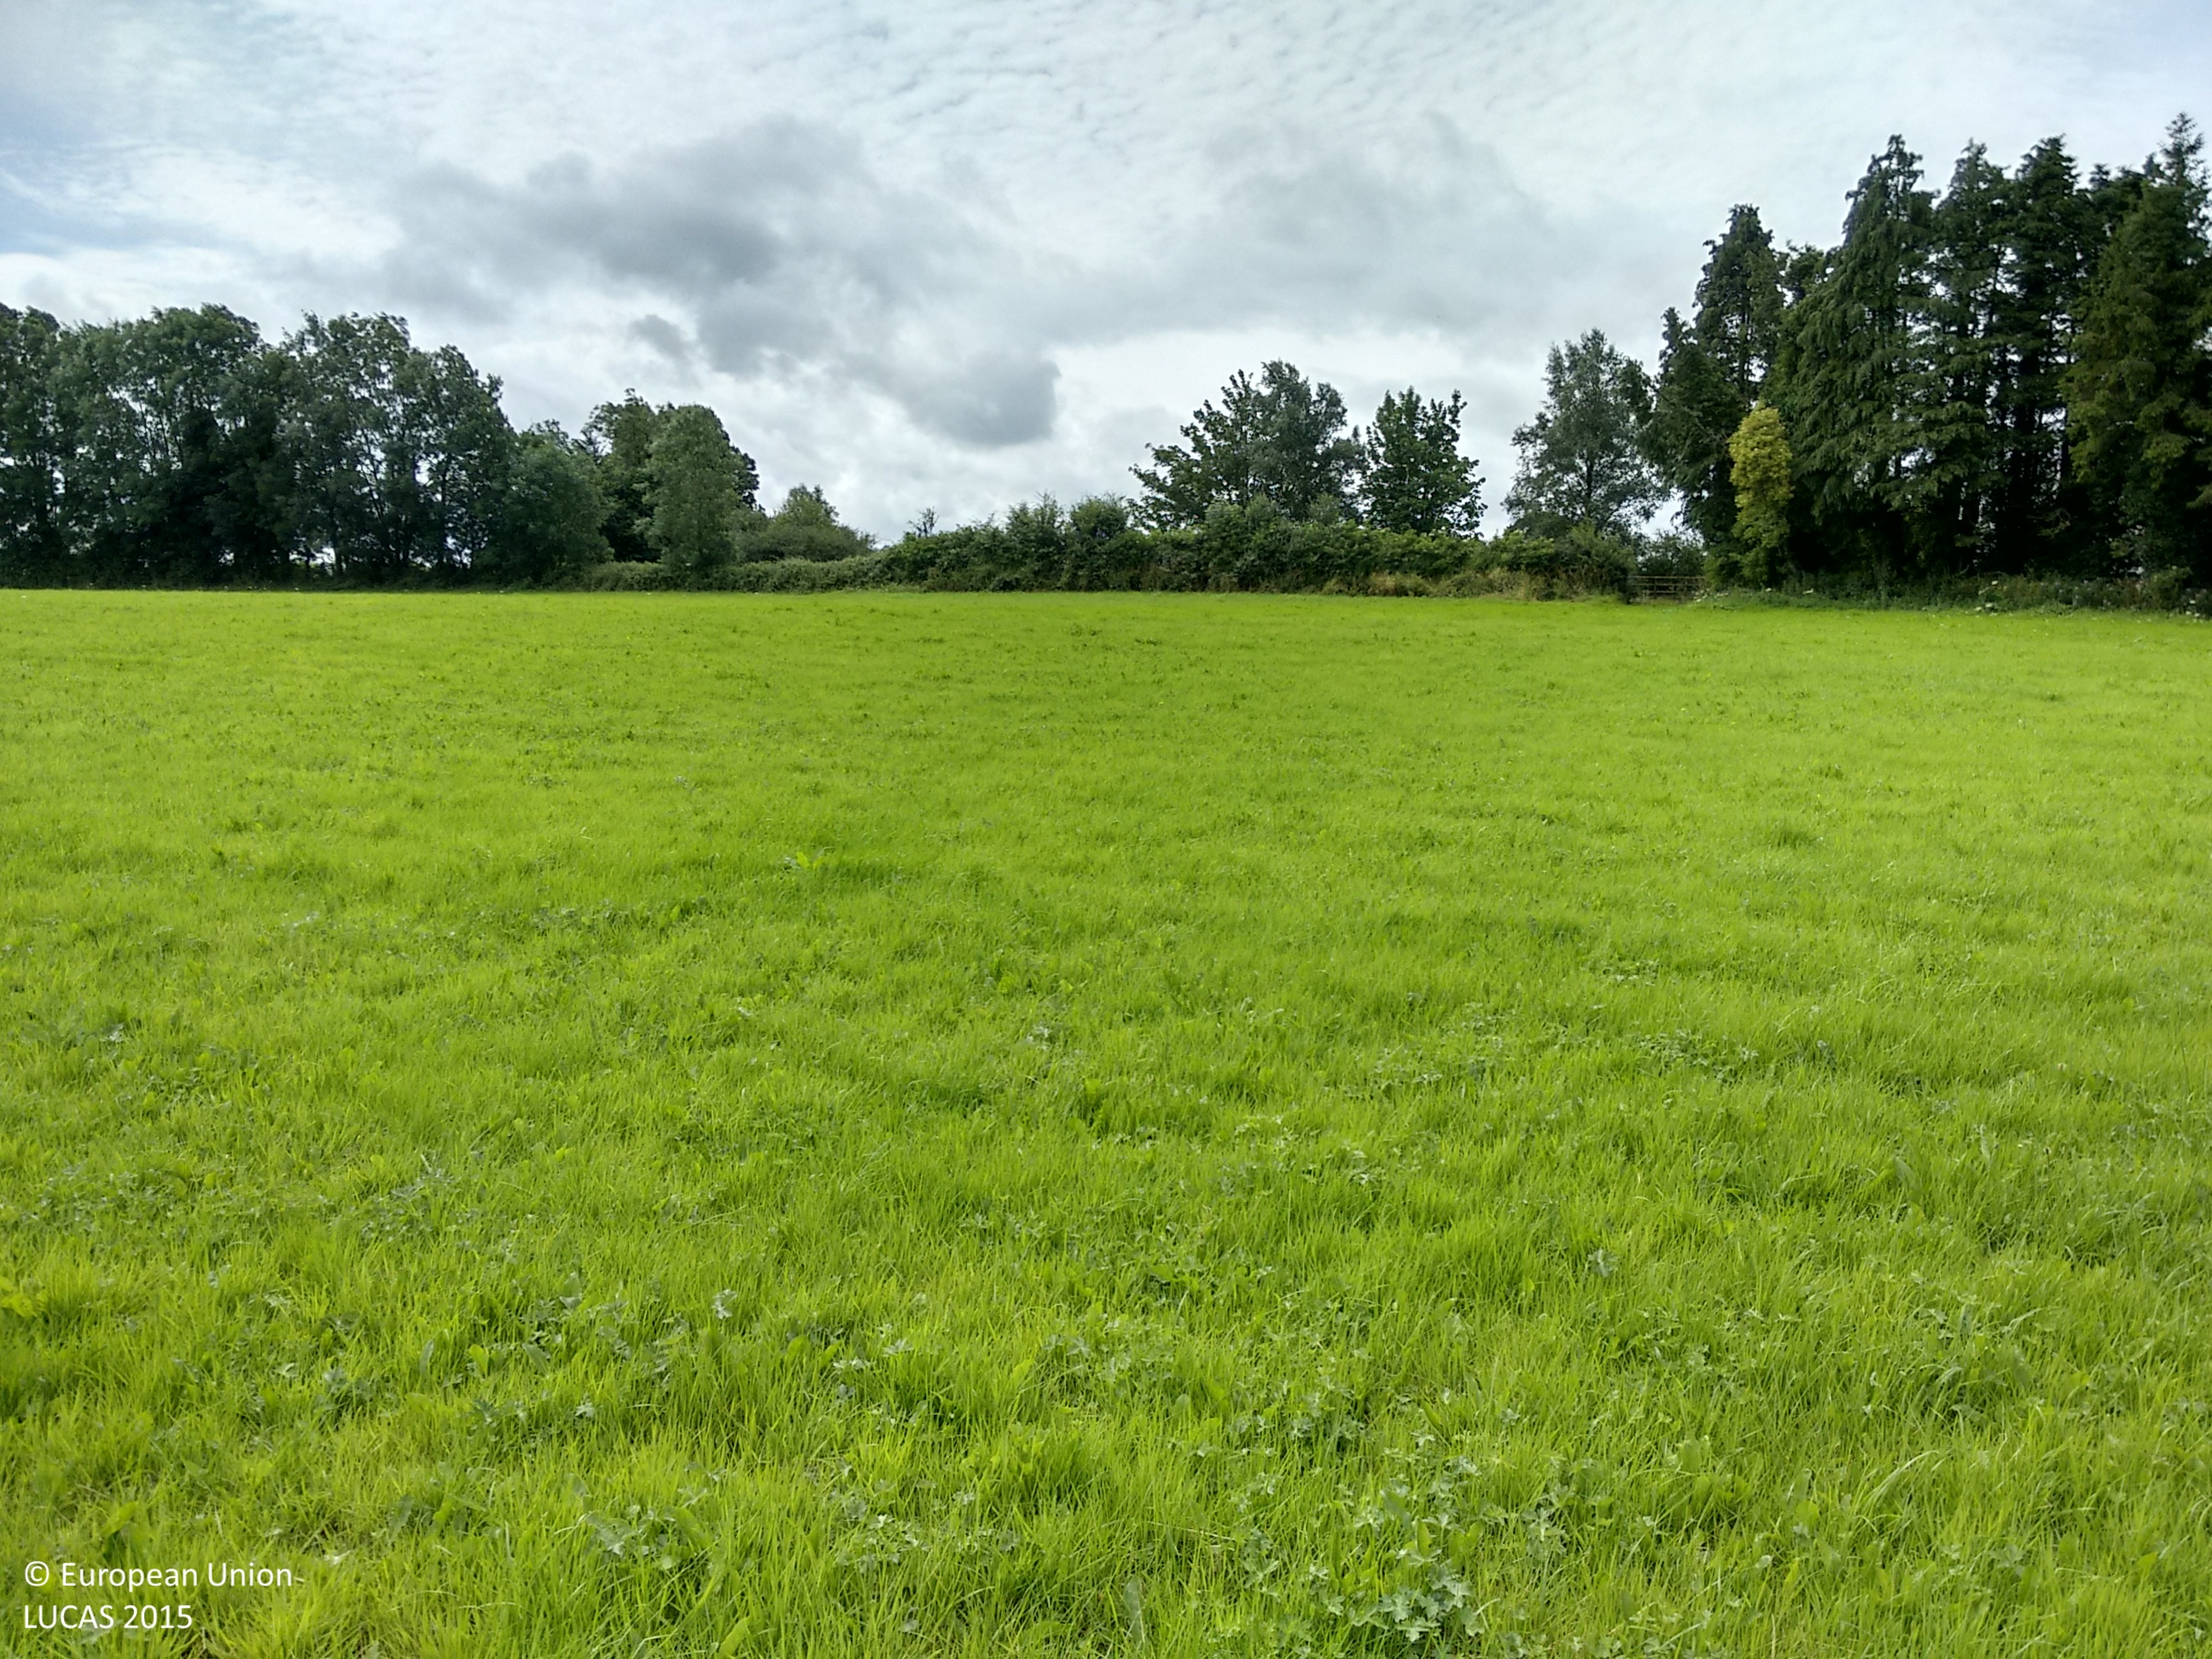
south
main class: Grassland
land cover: Grassland without tree/shrub cover
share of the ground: > 75 %
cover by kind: herbaceous plants 100 %
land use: Agriculture (excluding fallow land and kitchen gardens)
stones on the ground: < 10 %
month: July
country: IE
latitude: 53.5980
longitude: -7.6767
